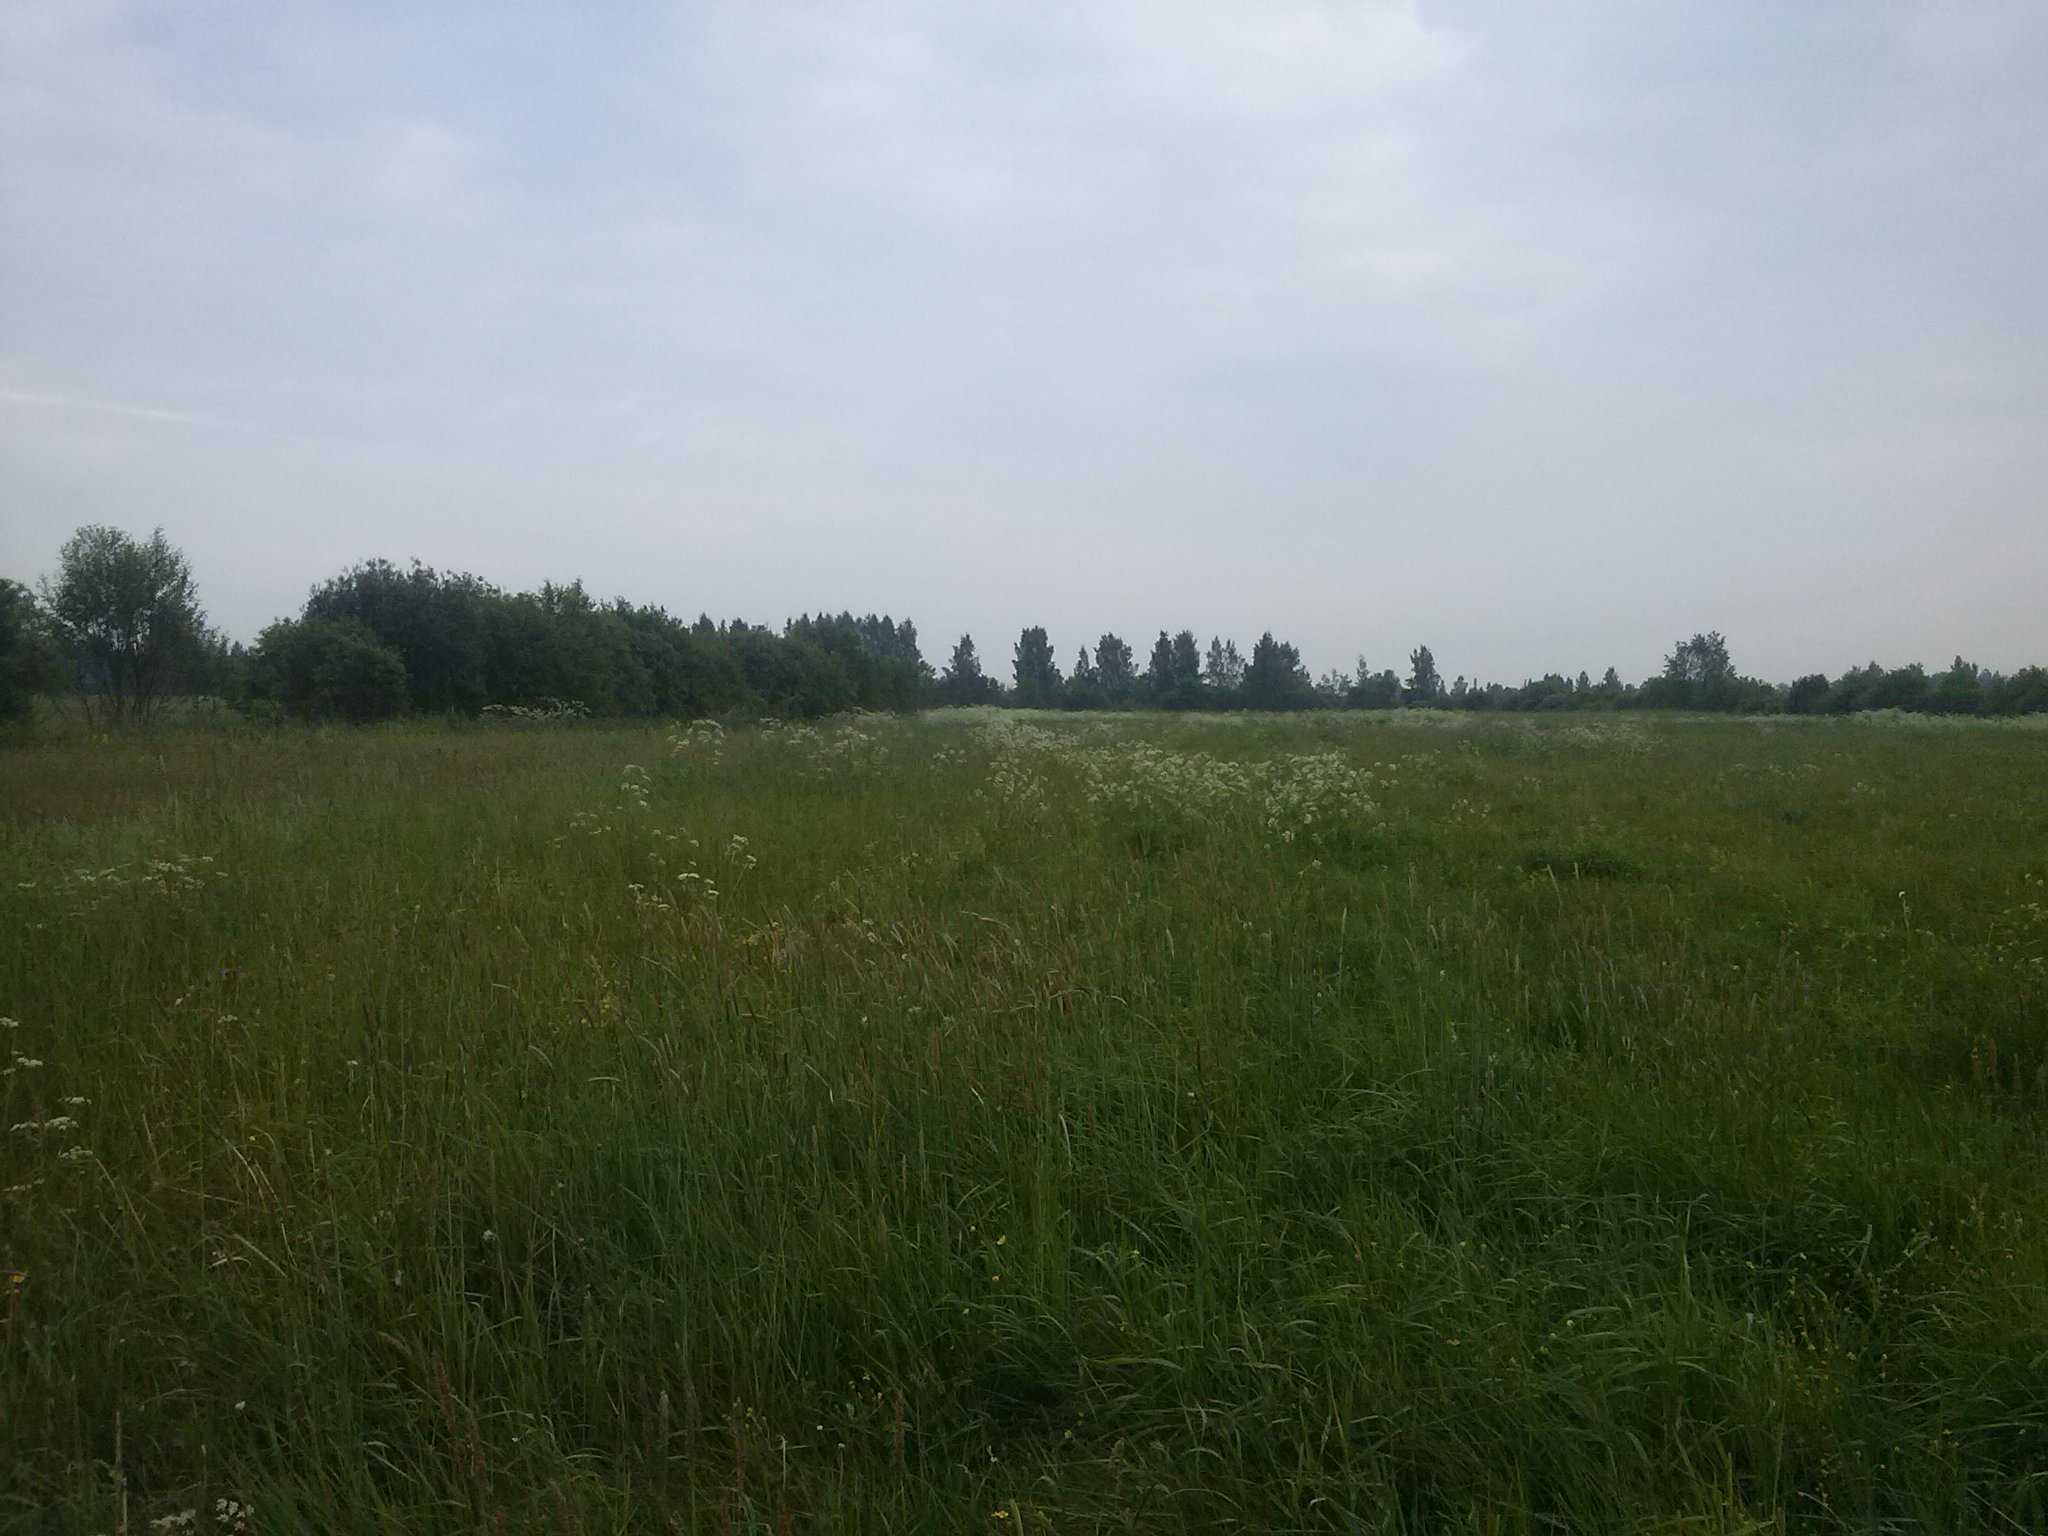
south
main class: Grassland
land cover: Grassland without tree/shrub cover
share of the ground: > 75 %
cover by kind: herbaceous plants 100 %
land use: Agriculture (excluding fallow land and kitchen gardens)
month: June
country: LV
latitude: 56.9297
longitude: 27.0714
